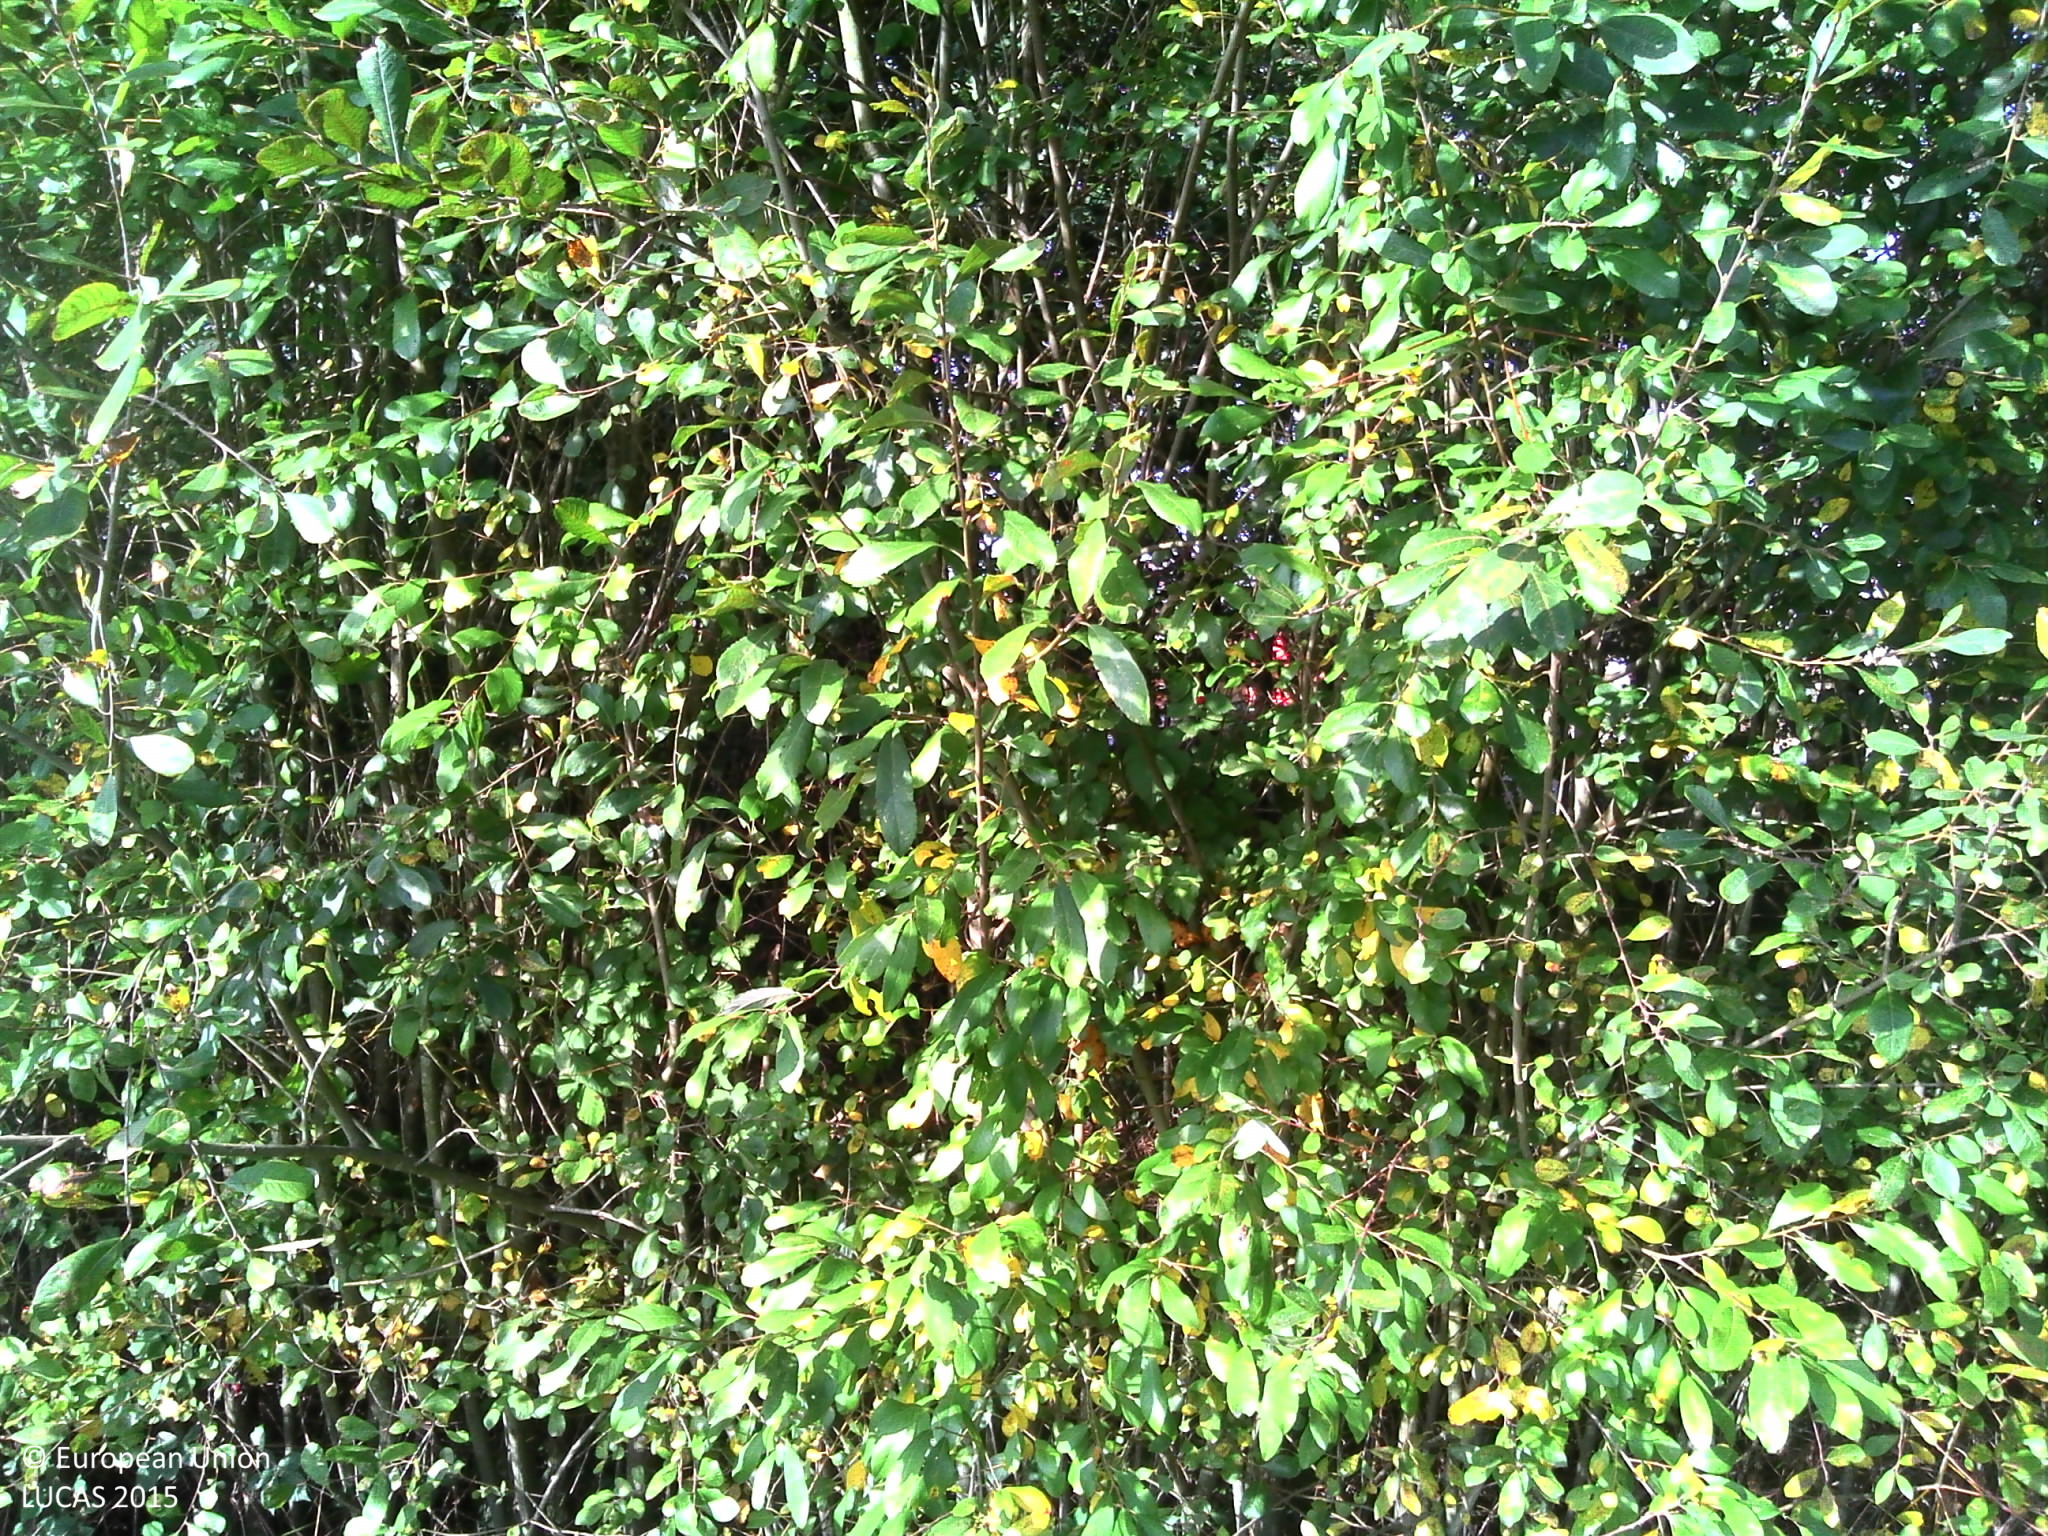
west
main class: Woodland
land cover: Broadleaved woodland
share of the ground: > 75 %
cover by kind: broadleaved forest trees 95 %, shrubs 5 %
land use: Semi-natural and natural areas not in use
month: October
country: FR
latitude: 47.2191
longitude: -0.9822
